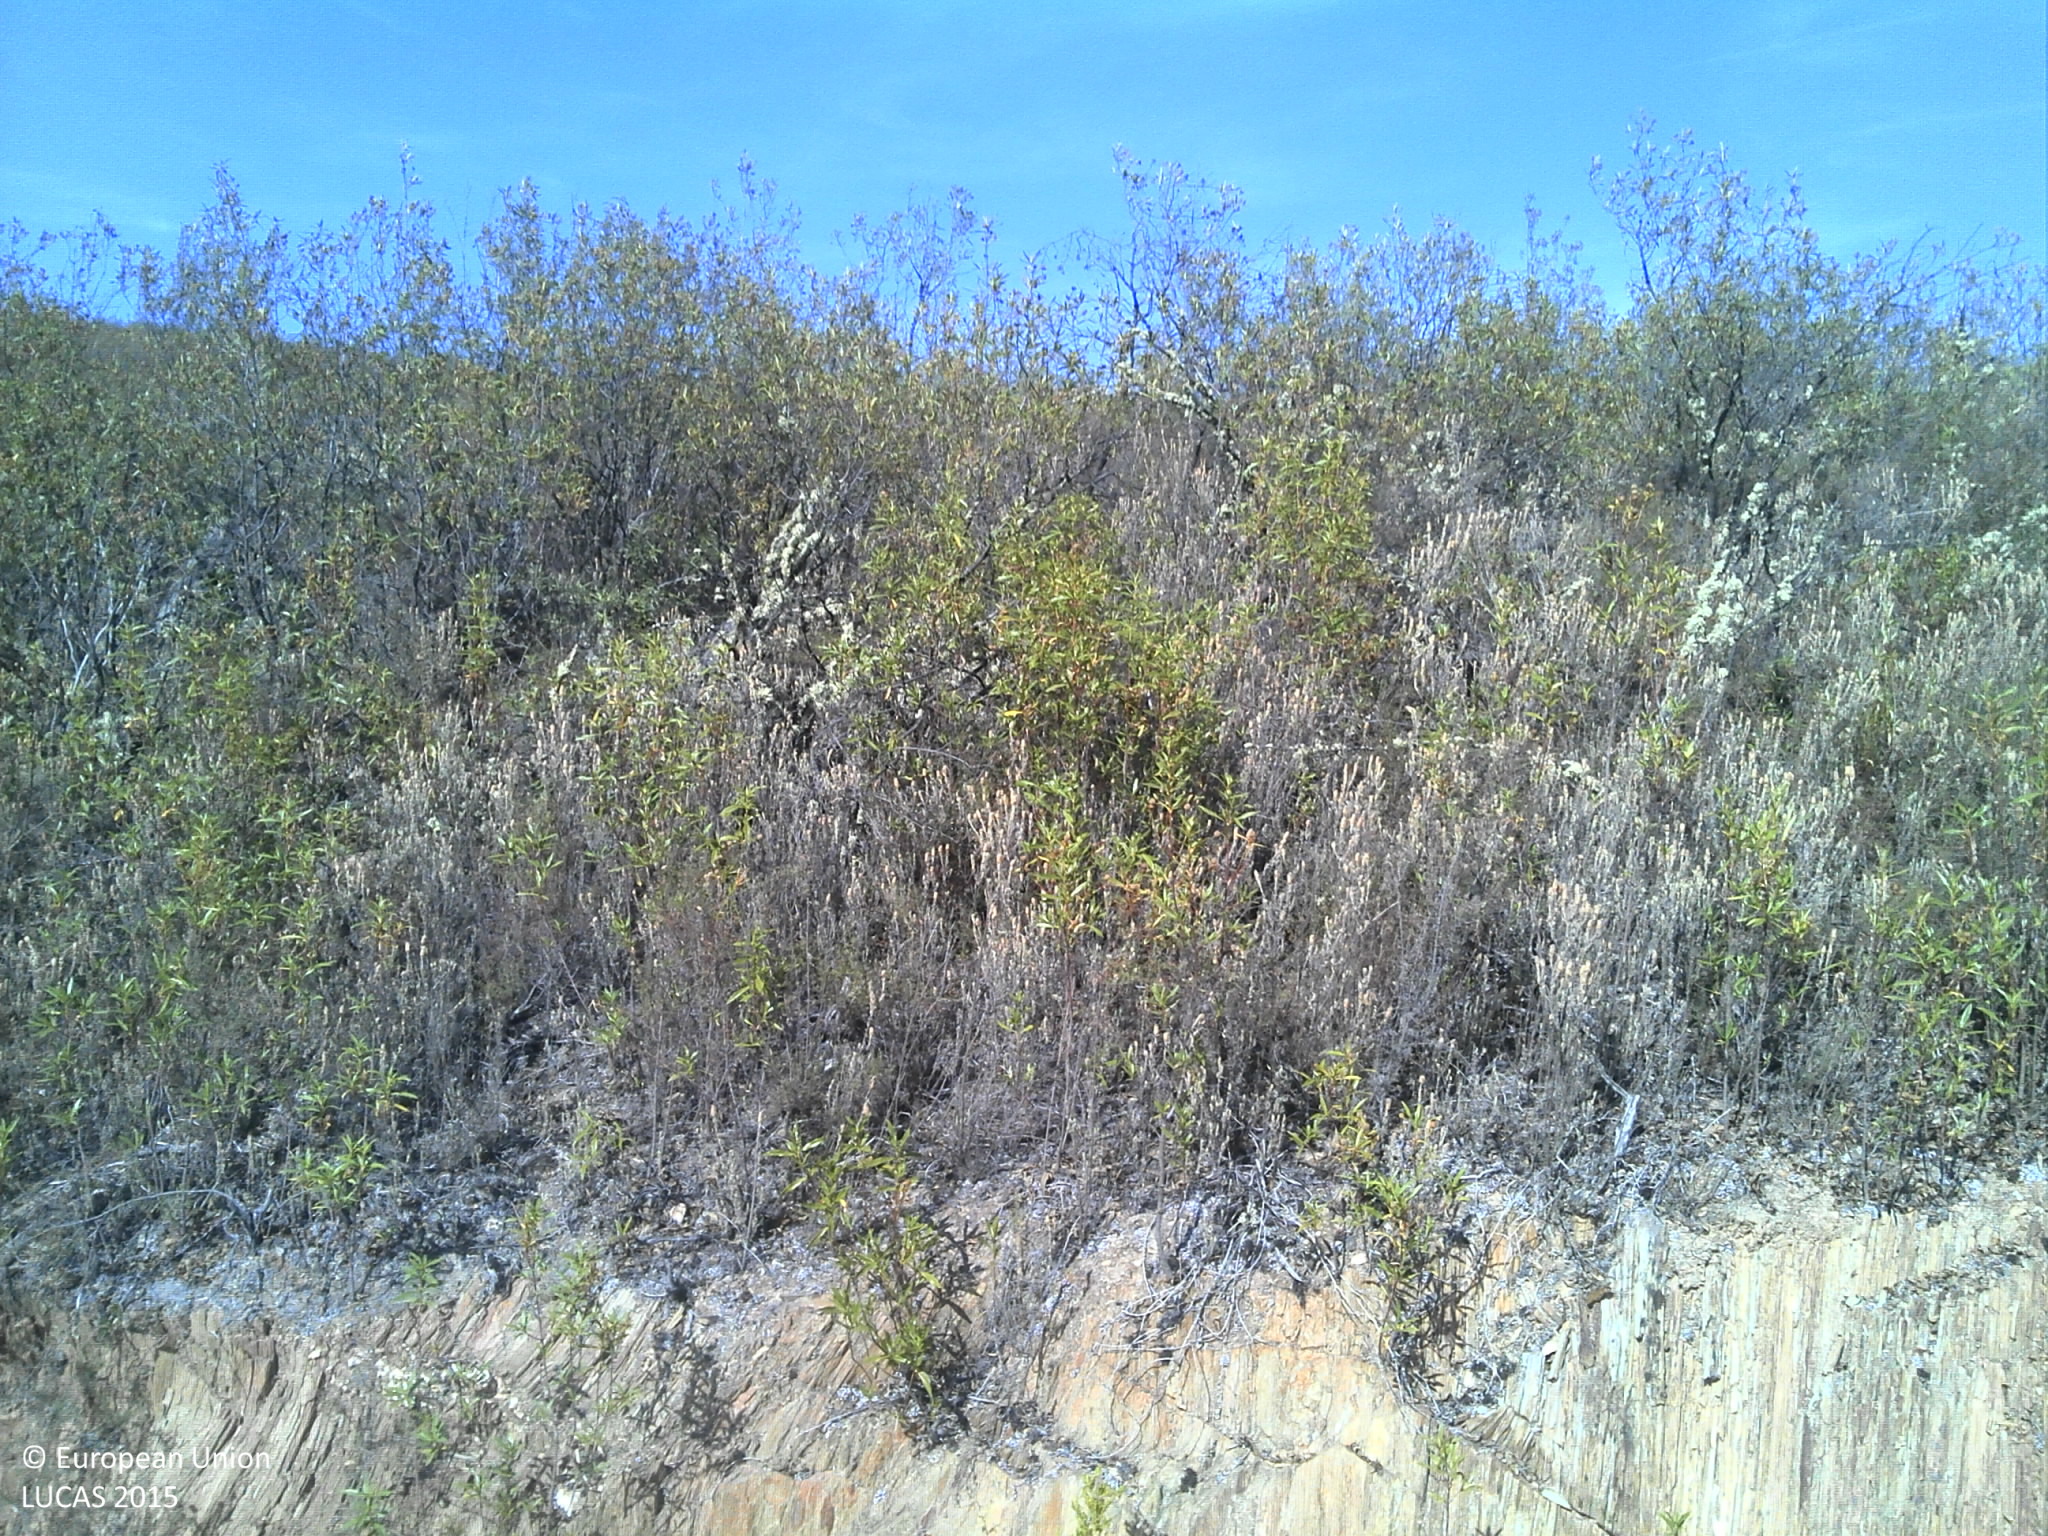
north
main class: Shrubland
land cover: Shrubland without tree cover
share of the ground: > 75 %
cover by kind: shrubs 85 %, unconsolidated bare surface 10 %, herbaceous plants 5 %
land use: Abandoned areas
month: July
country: PT
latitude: 39.6728
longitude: -7.5256
